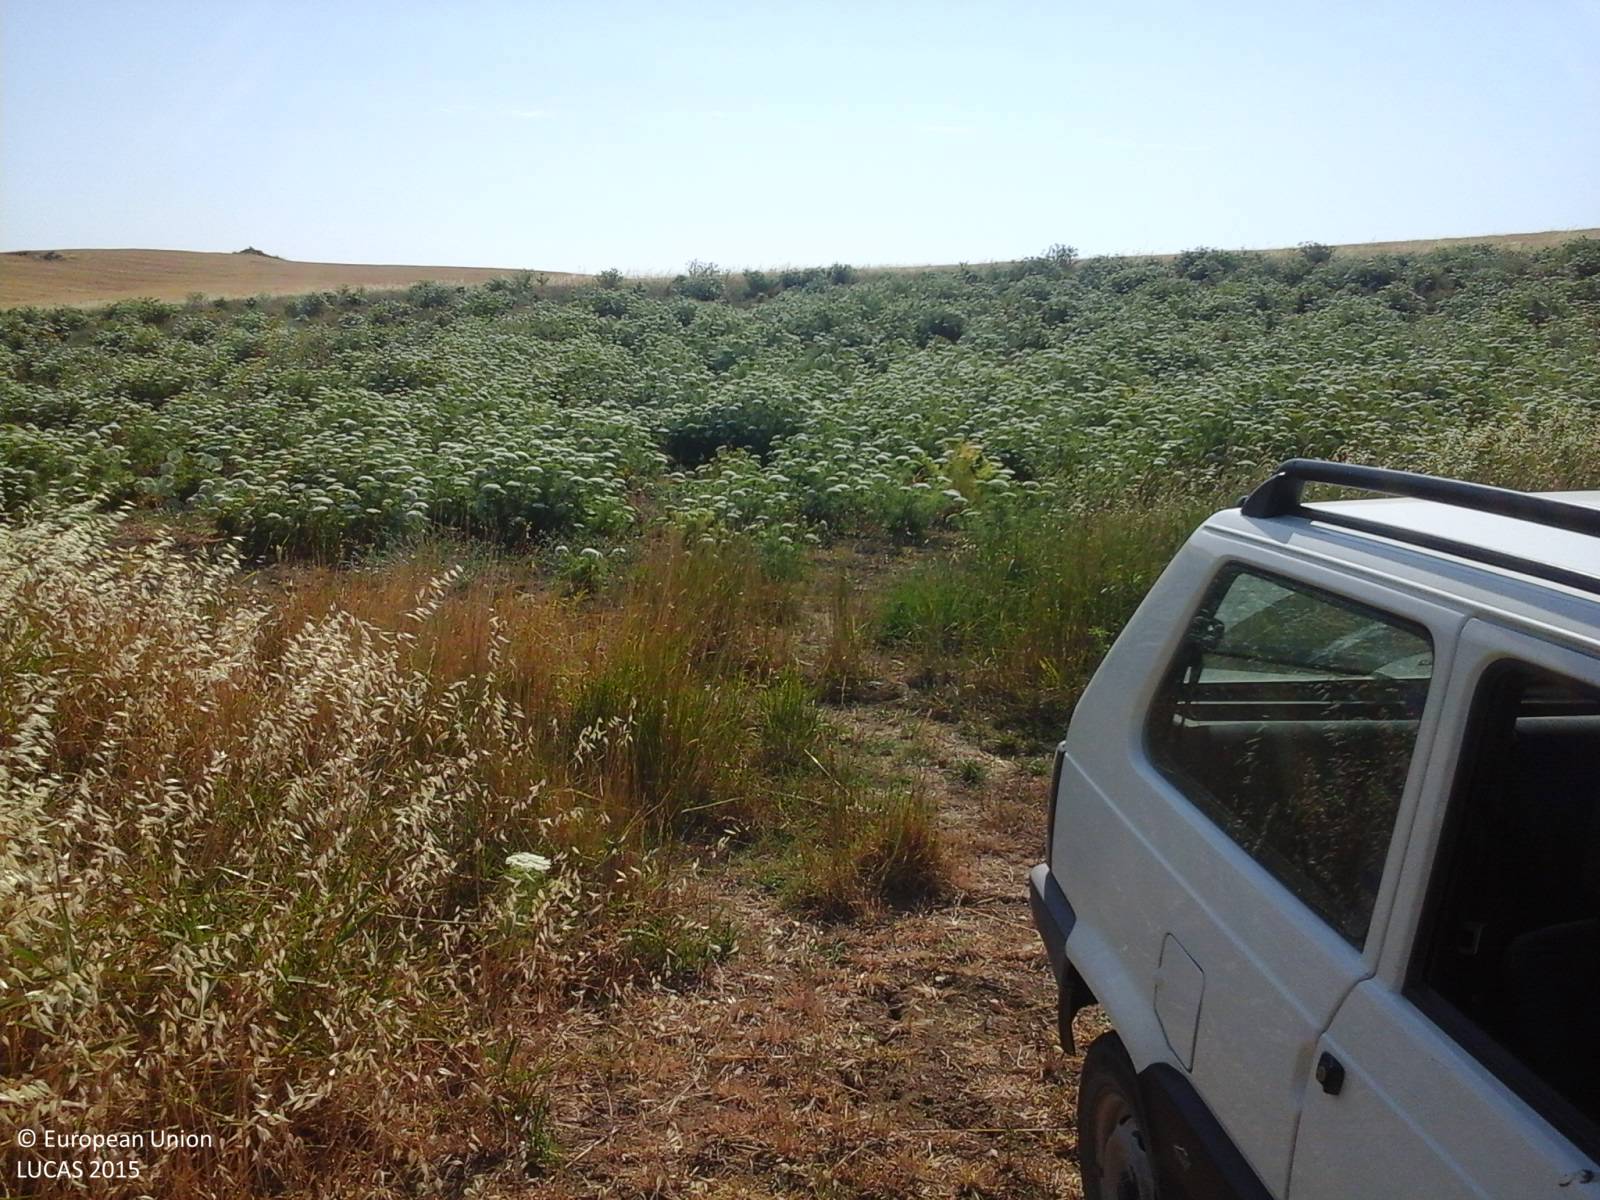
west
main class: Cropland
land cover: Other leguminous and mixtures for fodder
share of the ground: > 75 %
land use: Agriculture (excluding fallow land and kitchen gardens)
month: June
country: IT
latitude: 37.8909
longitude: 12.6979
